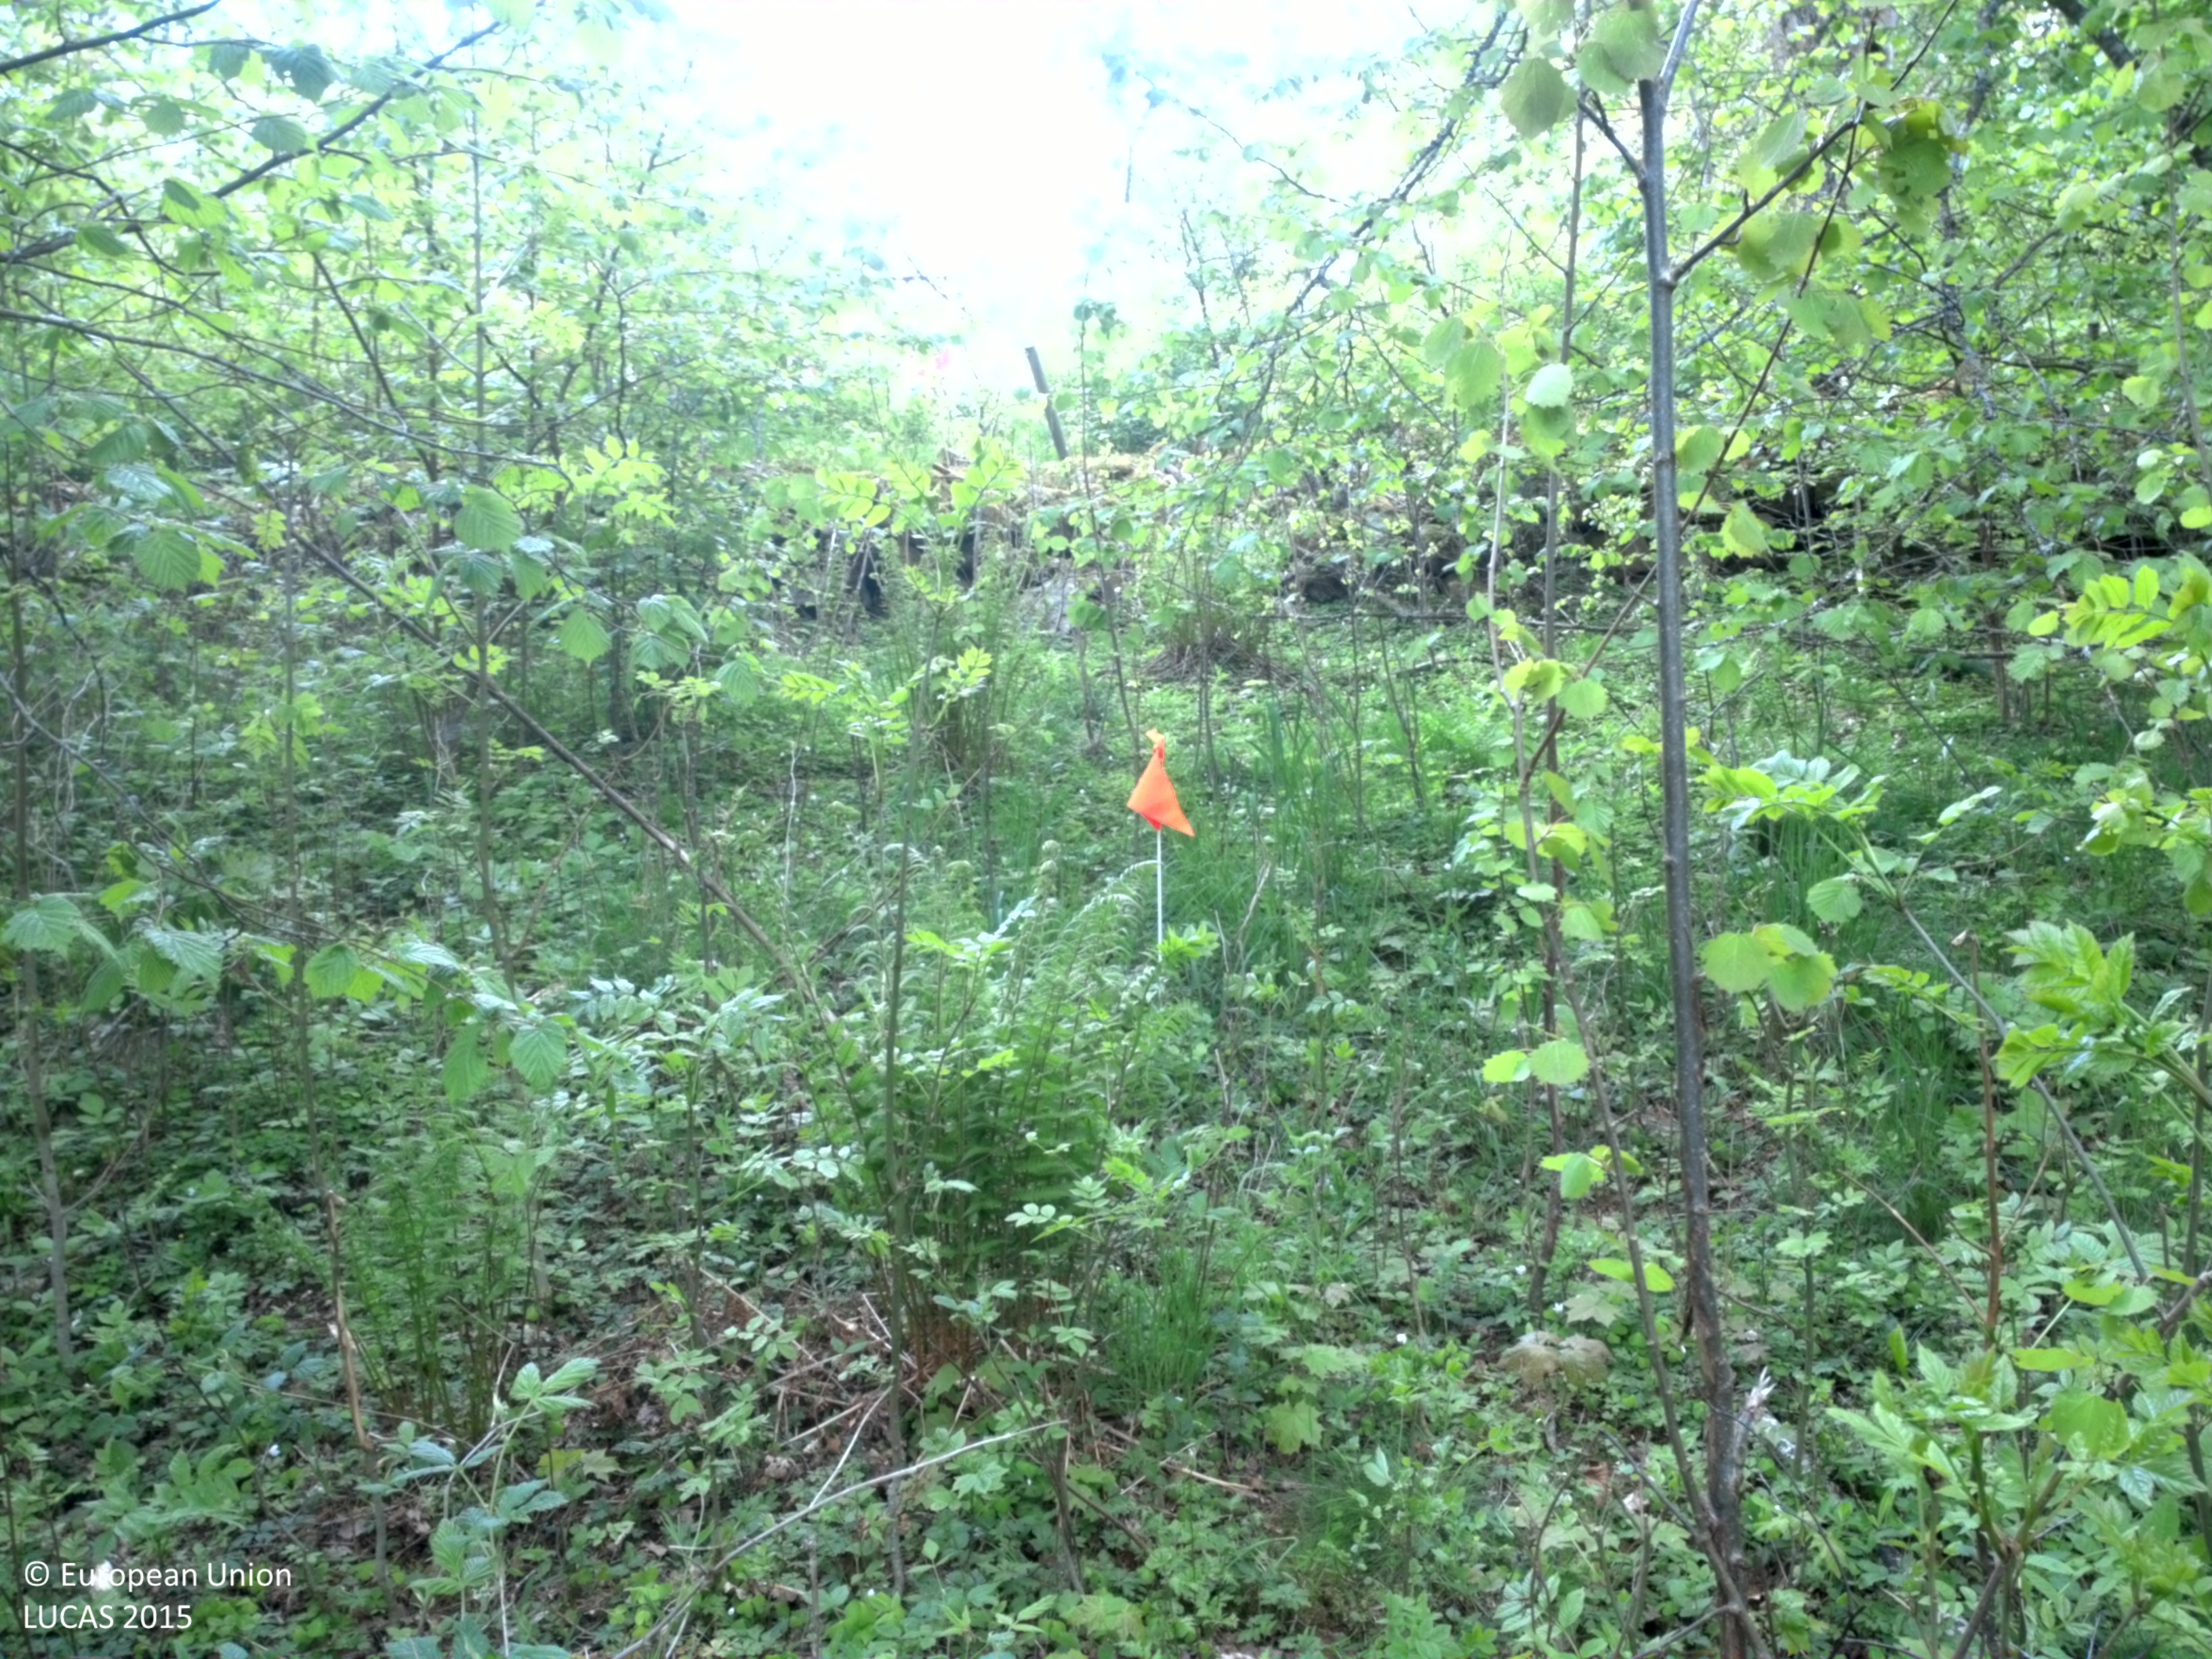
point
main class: Woodland
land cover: Broadleaved woodland
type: mesophytic deciduous forest
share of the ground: > 75 %
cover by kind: broadleaved forest trees 90 %, shrubs 5 %, herbaceous plants 5 %
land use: Forestry
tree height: > 5 m
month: May
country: SE
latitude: 56.5207
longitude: 15.0532
